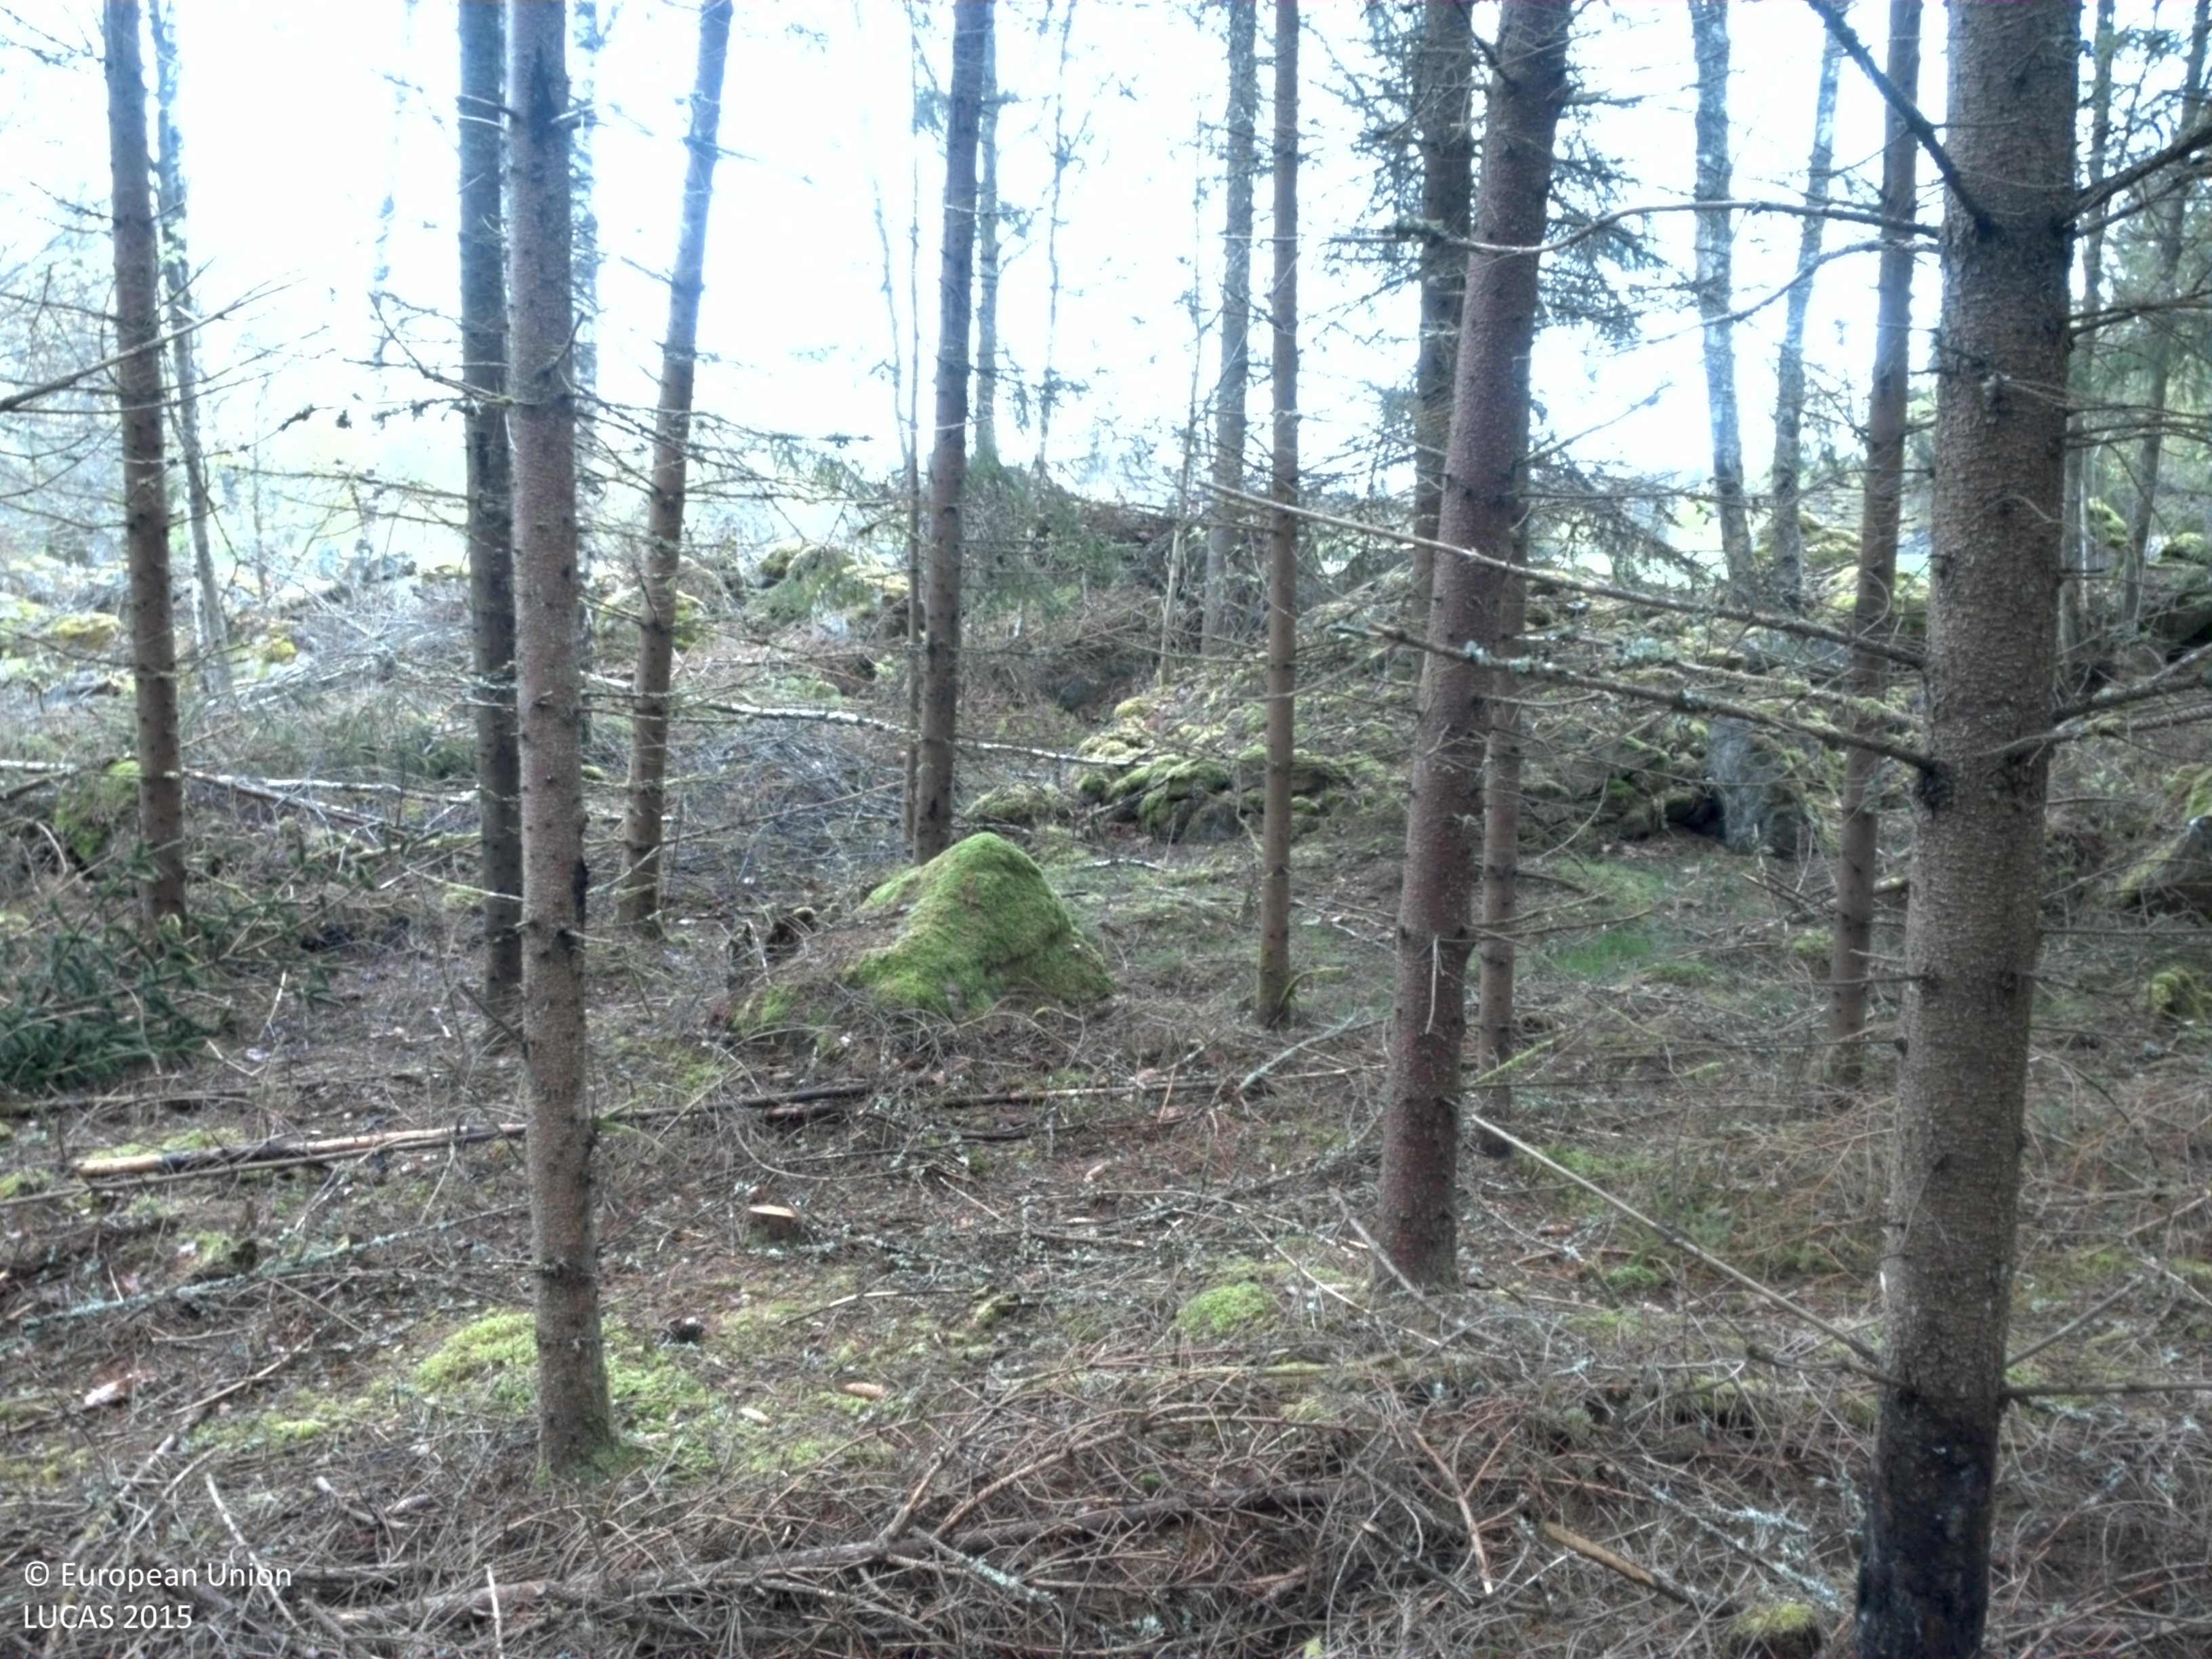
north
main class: Woodland
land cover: Spruce dominated coniferous woodland
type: boreal forest
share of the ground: > 75 %
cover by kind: coniferous forest trees 70 %, lichens and mosses 20 %, broadleaved forest trees 10 %
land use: Forestry
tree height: > 5 m
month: May
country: SE
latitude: 56.6103
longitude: 15.0650
